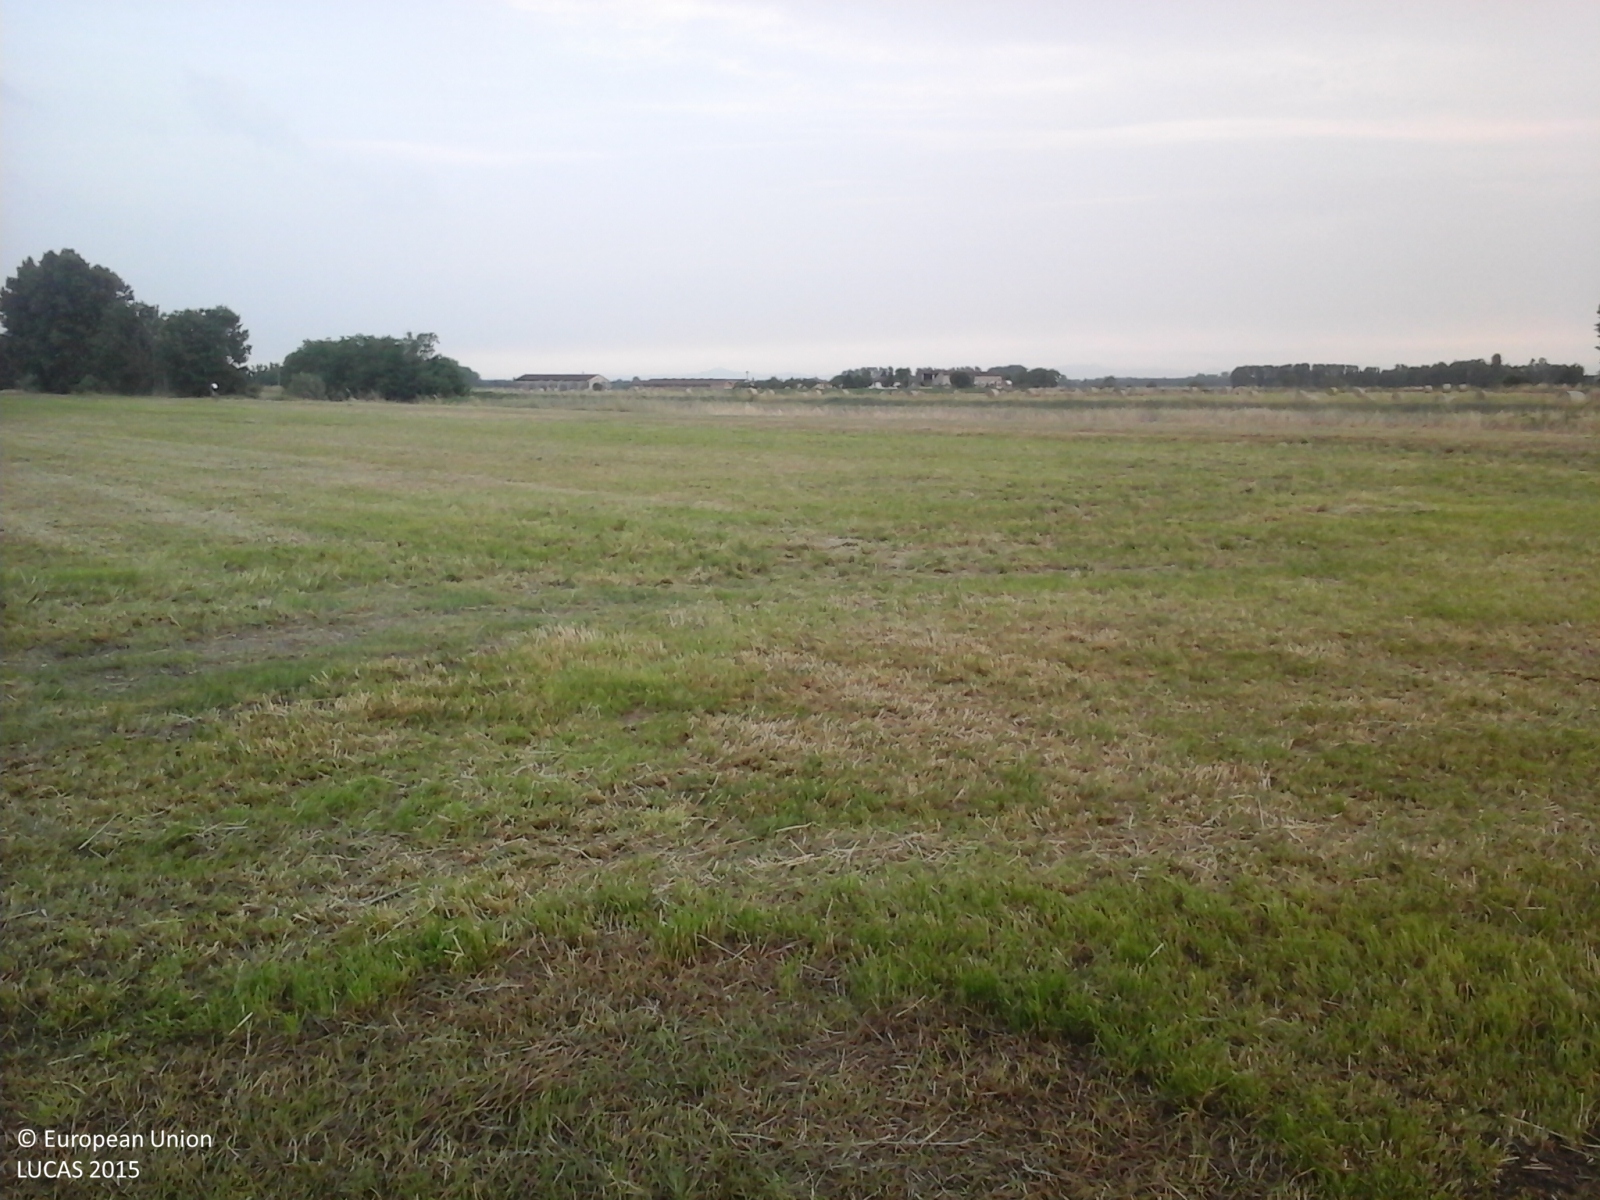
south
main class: Grassland
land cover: Grassland without tree/shrub cover
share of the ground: > 75 %
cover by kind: herbaceous plants 100 %
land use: Agriculture (excluding fallow land and kitchen gardens)
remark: Harvested field
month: May
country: IT
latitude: 45.2137
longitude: 10.6990
